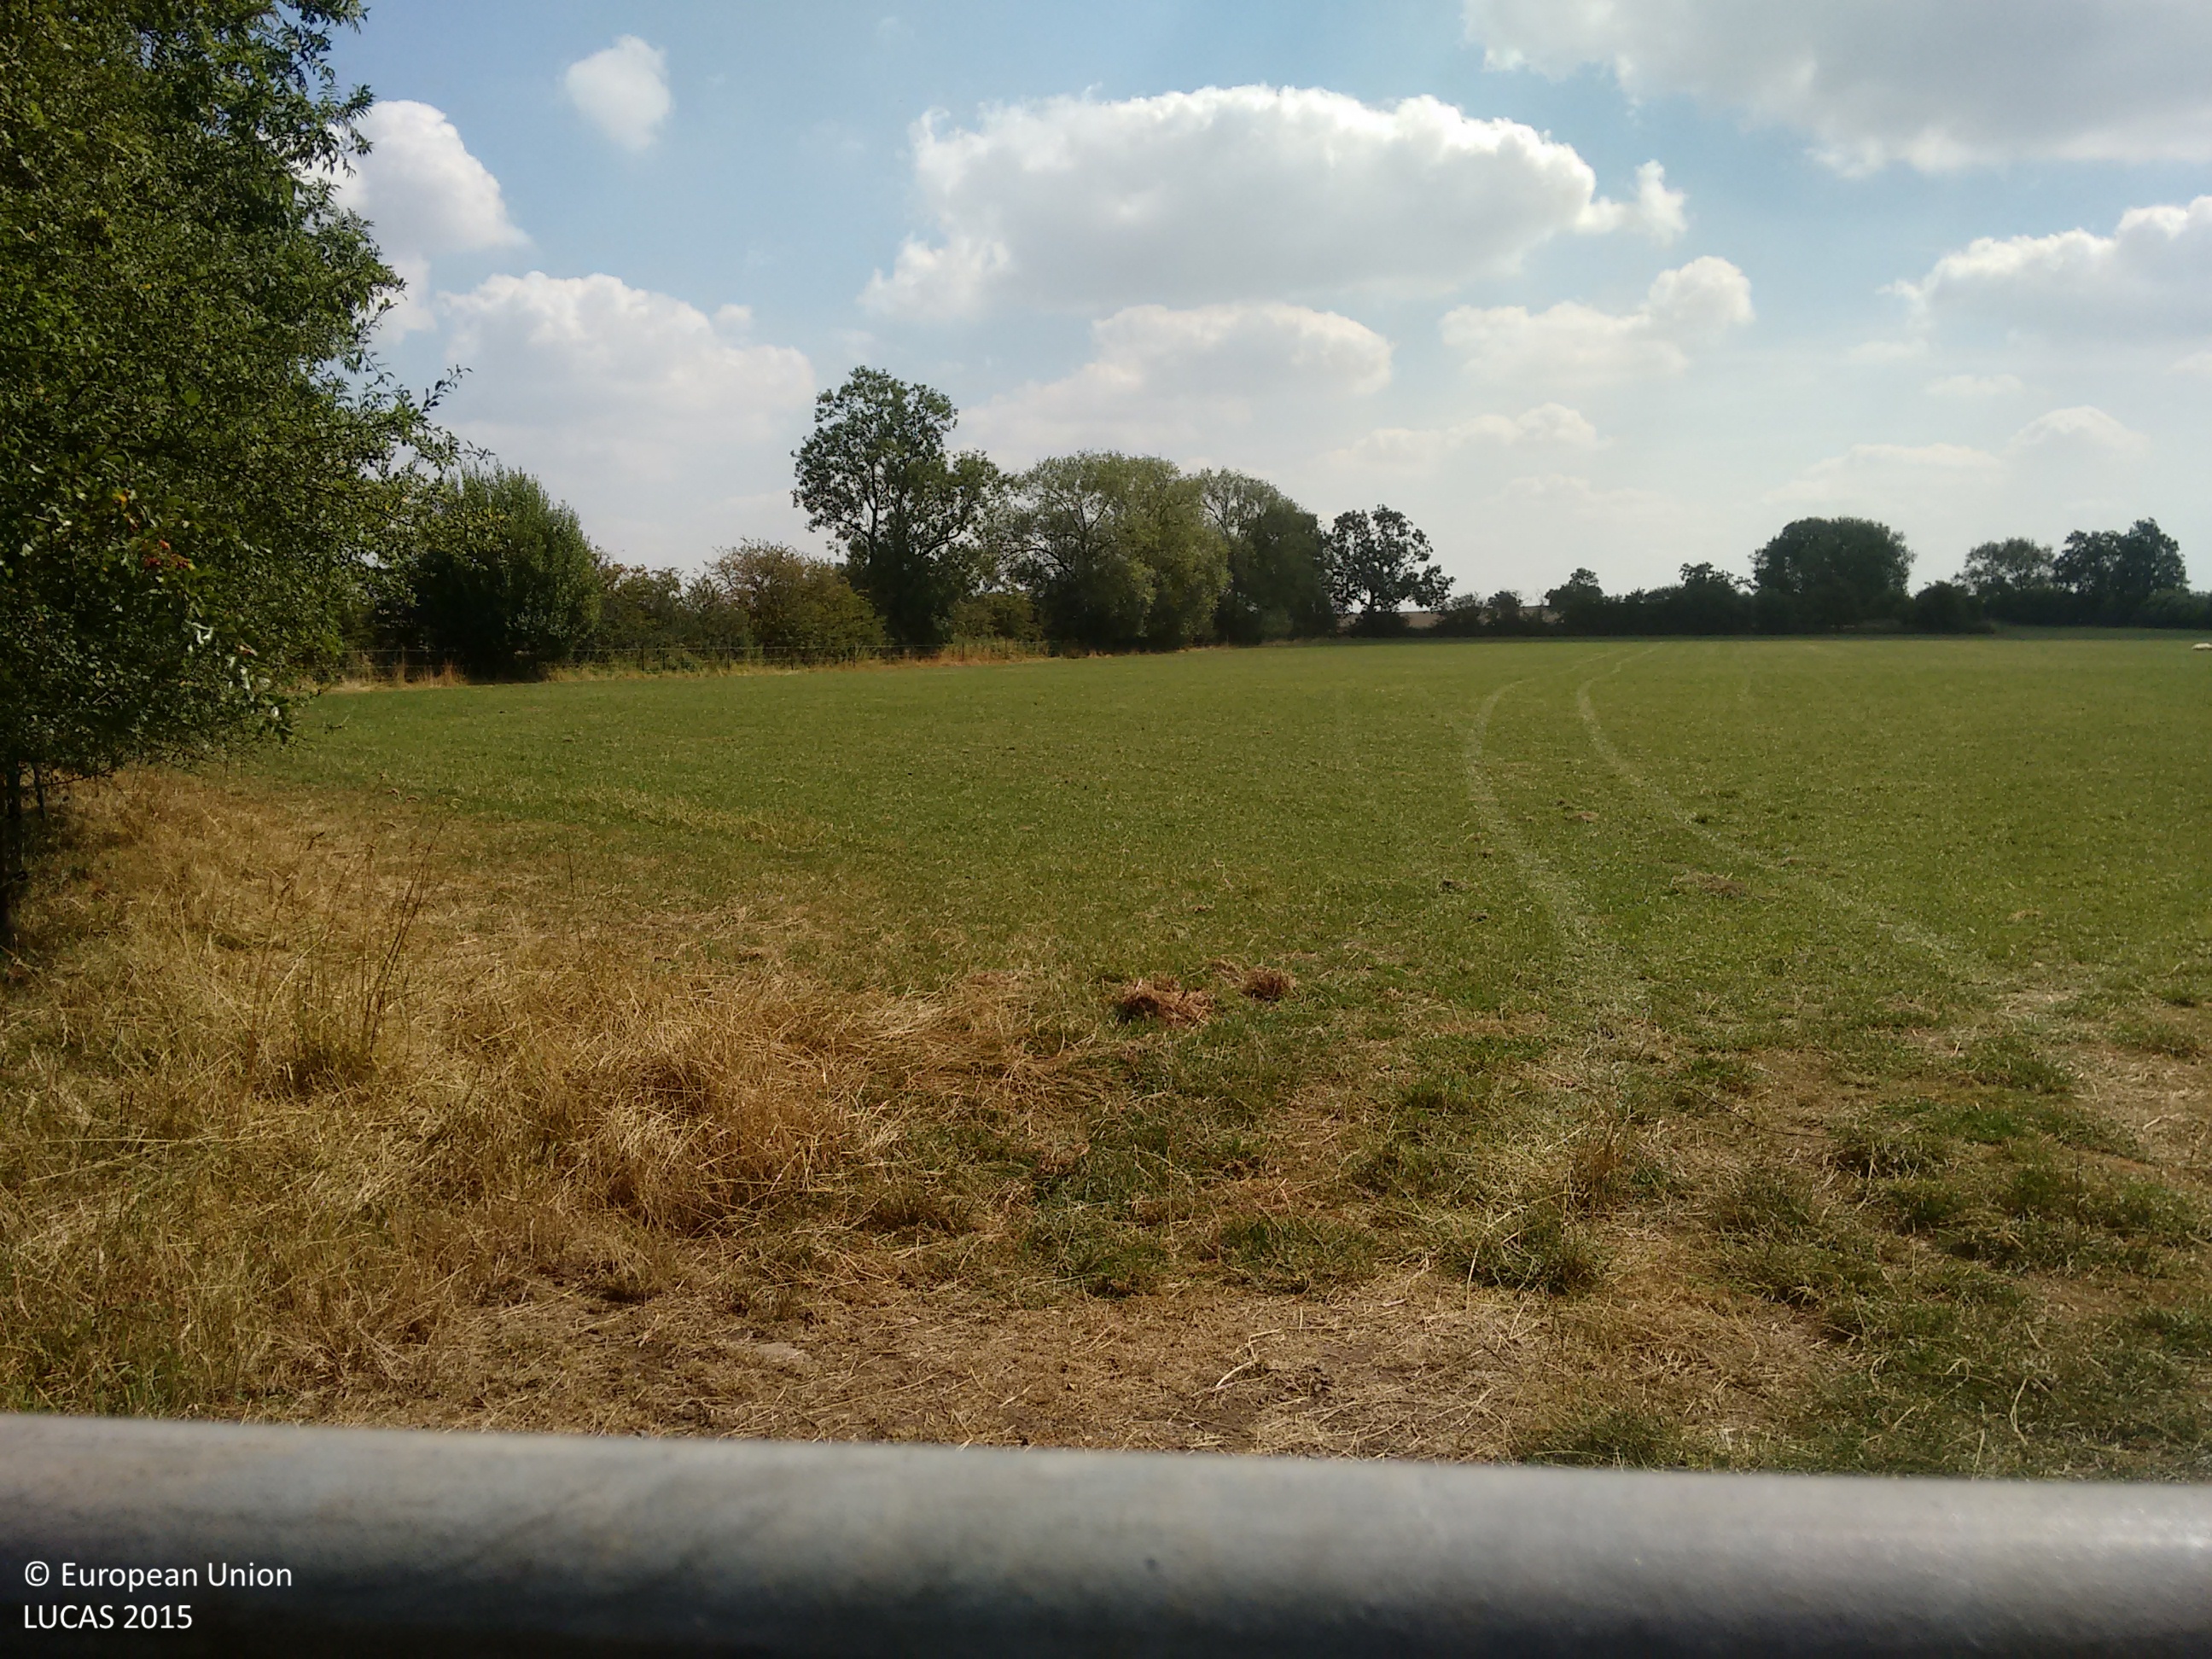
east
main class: Grassland
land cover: Grassland without tree/shrub cover
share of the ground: > 75 %
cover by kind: herbaceous plants 100 %
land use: Agriculture (excluding fallow land and kitchen gardens)
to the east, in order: Grassland without tree/shrub cover; Fences; Managed hedges; Ditches and canals; Managed hedges; Grass margins; Common wheat
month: August
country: GB
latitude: 52.6160
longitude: -1.4974
